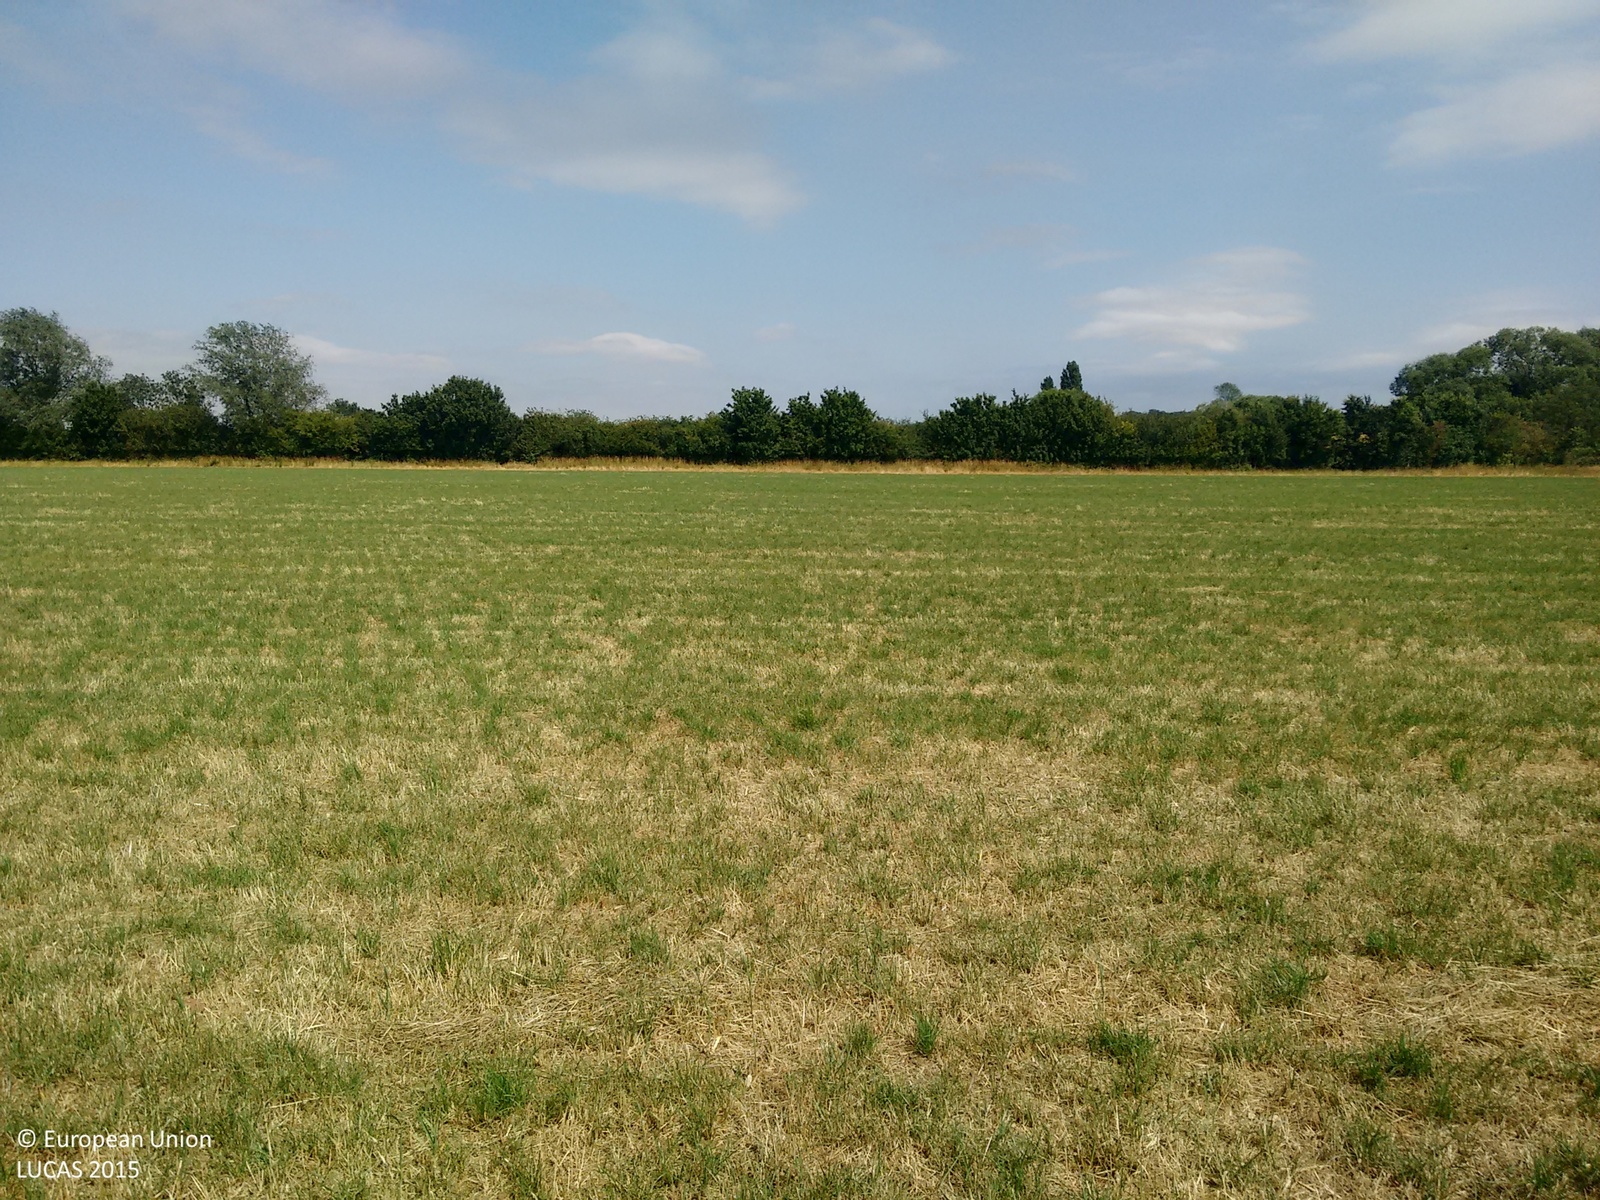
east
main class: Cropland
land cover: Temporary grasslands
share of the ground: > 75 %
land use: Agriculture (excluding fallow land and kitchen gardens)
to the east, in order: Temporary grasslands; Grass margins; Managed hedges; Ditches and canals; Managed hedges; Grass margins; Rape and turnip rape
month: July
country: GB
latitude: 51.7116
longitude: 0.3463
